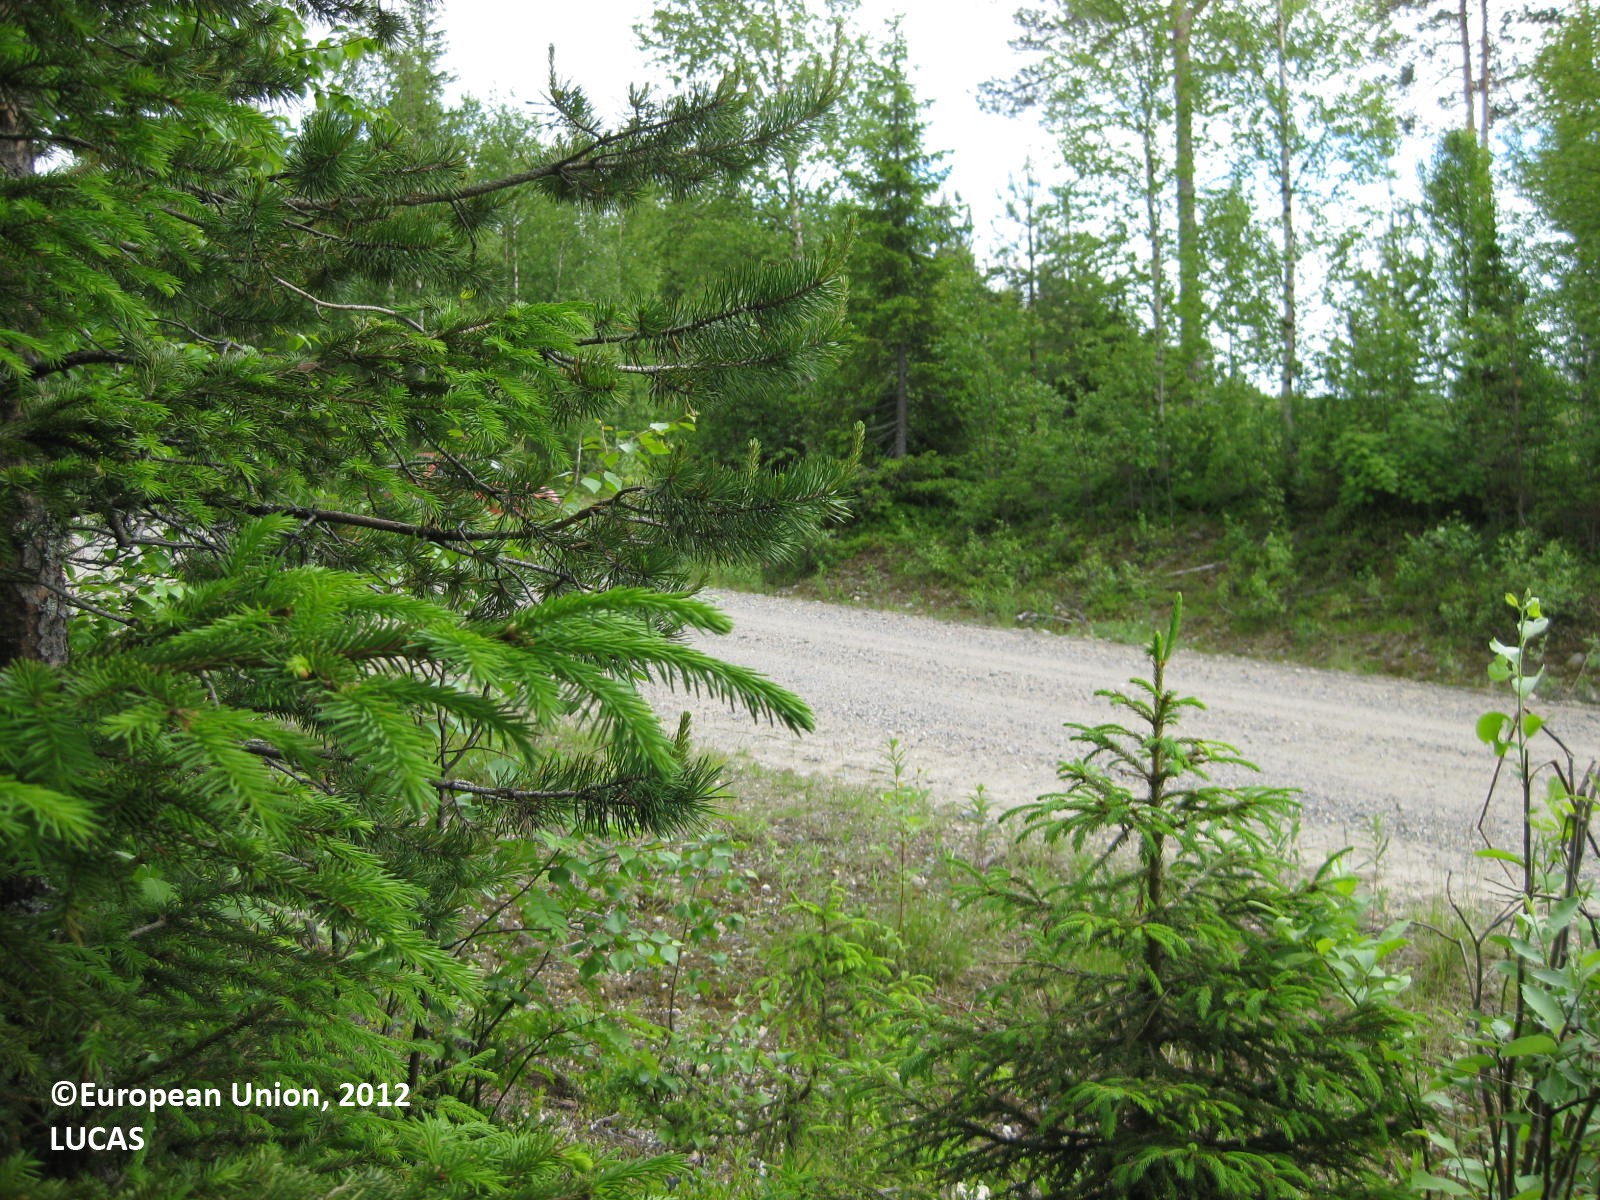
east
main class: Woodland
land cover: Spruce dominated mixed woodland
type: boreal forest
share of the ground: > 75 %
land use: Forestry
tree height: > 5 m
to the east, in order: Spruce dominated mixed woodland; Ditches and canals; Grass margins; Paved roads, cycling and walking lanes; Abandoned hedges; Tracks; Pine dominated mixed woodland; Ditches and canals; Pine dominated mixed woodland; Ditches and canals; Pine dominated mixed woodland; Ditches and canals; Pine dominated coniferous woodland; Ditches and canals; Pine dominated mixed woodland; Ditches and canals; Pine dominated mixed woodland; Ditches and canals; Pine dominated mixed woodland
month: June
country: FI
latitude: 65.3003
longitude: 28.2803
